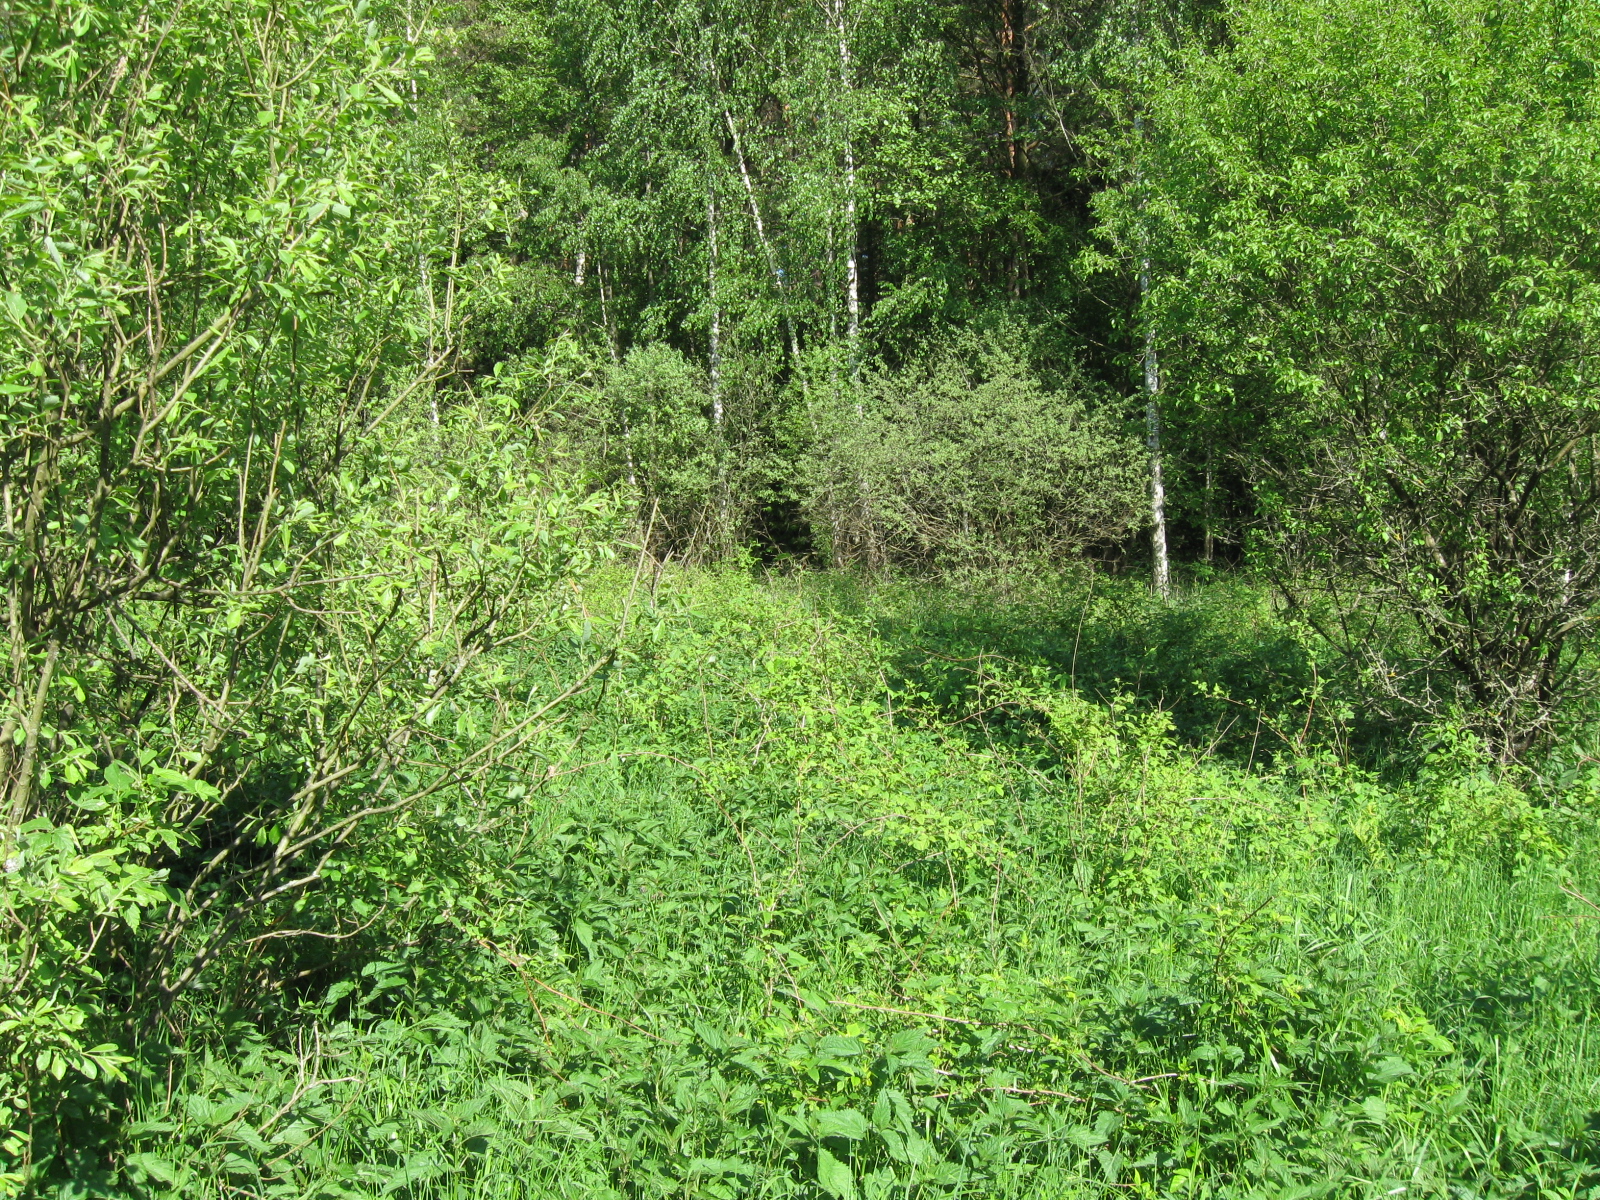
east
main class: Shrubland
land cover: Shrubland with sparse tree cover
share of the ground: > 75 %
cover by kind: herbaceous plants 50 %, shrubs 45 %, broadleaved forest trees 5 %
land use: Forestry
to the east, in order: Shrubland with sparse tree cover; Broadleaved woodland; Other mixed woodland; Pine dominated mixed woodland; Tracks; Pine dominated mixed woodland
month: June
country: LT
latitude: 54.1410
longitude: 23.6323
